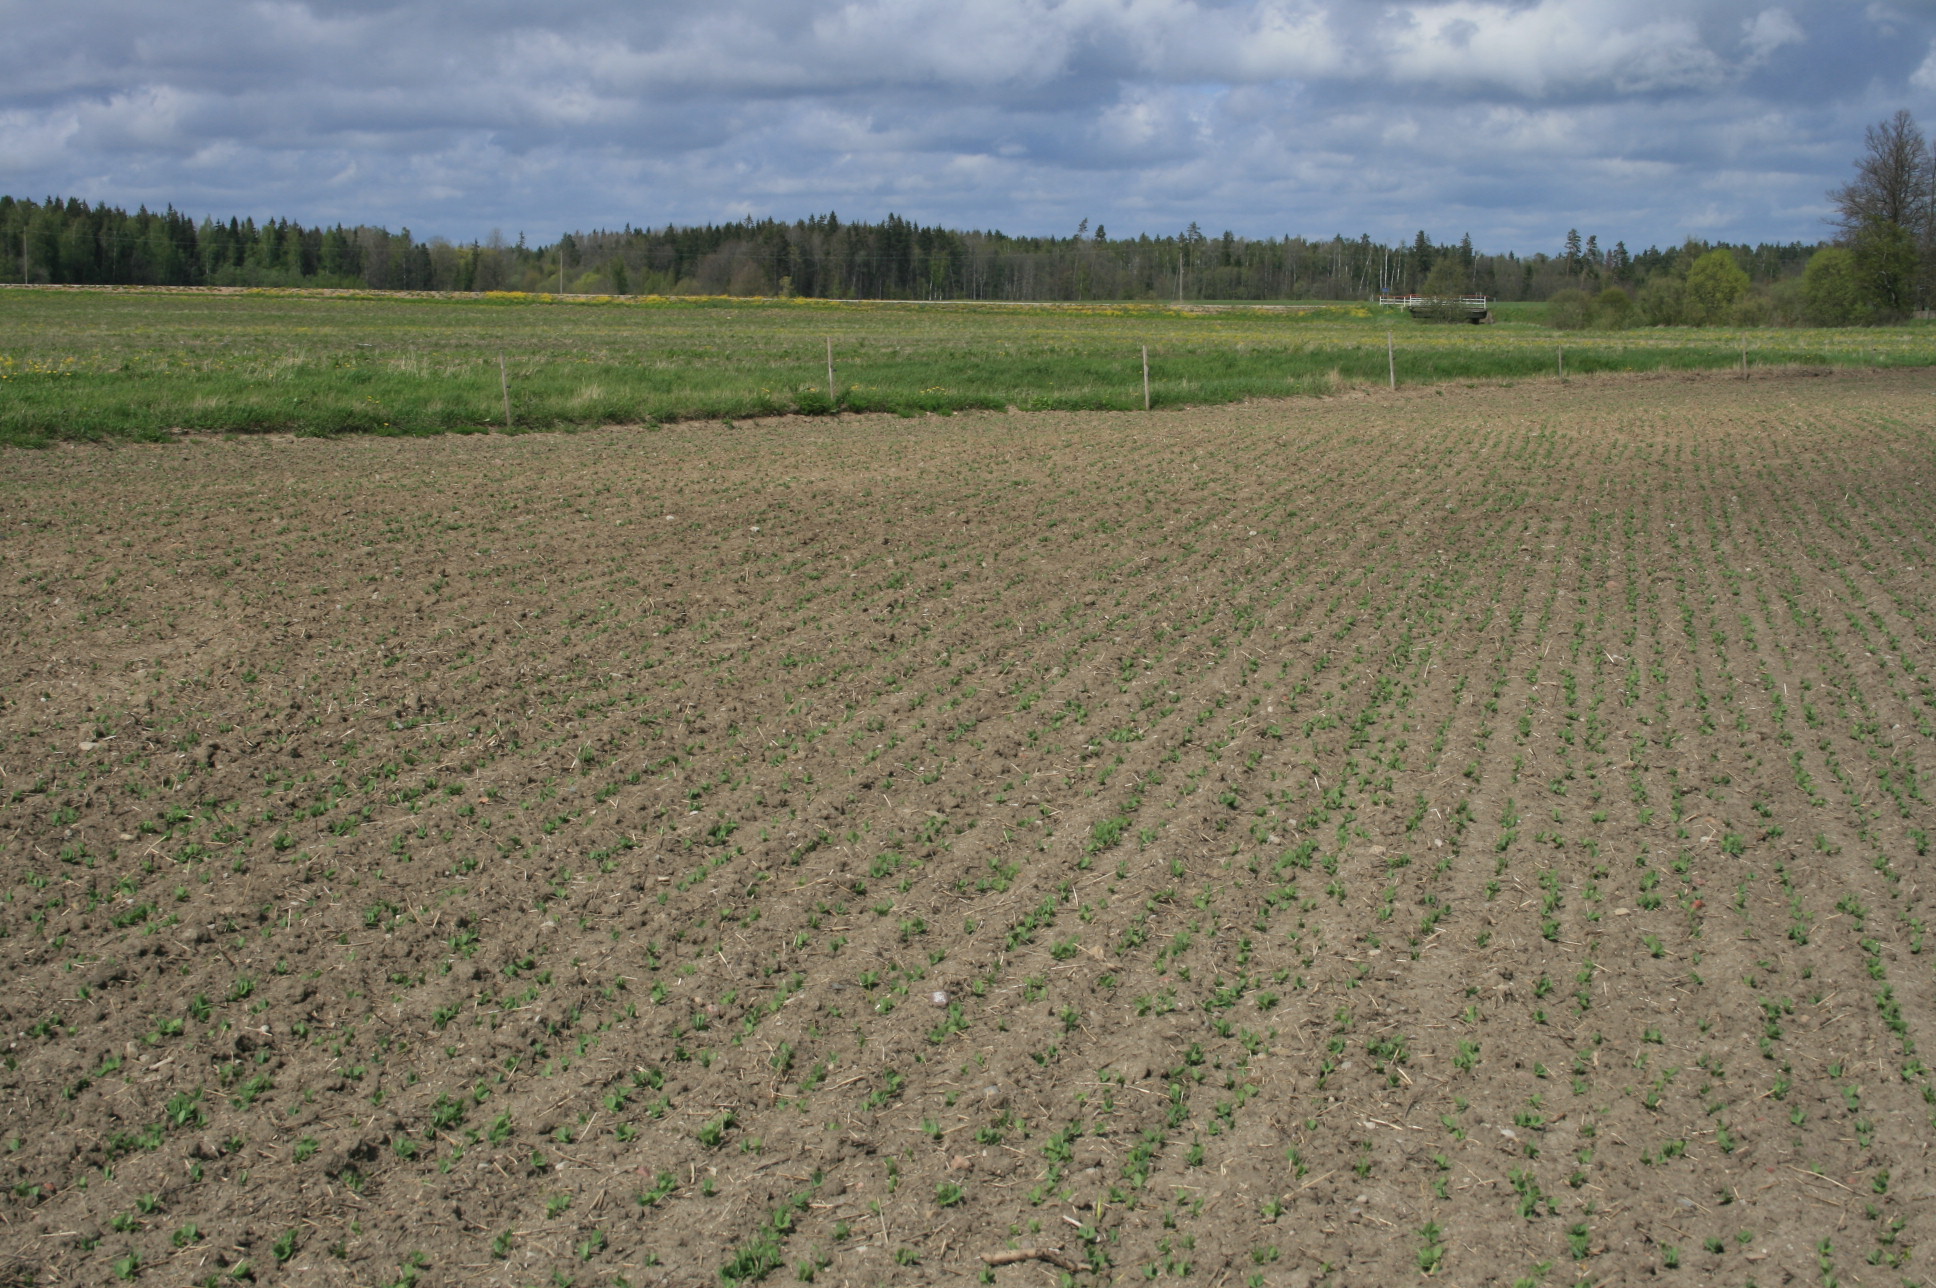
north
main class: Cropland
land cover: Dry pulses
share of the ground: 10 - 25 %
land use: Agriculture (excluding fallow land and kitchen gardens)
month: May
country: LT
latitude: 56.1690
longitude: 21.3962
